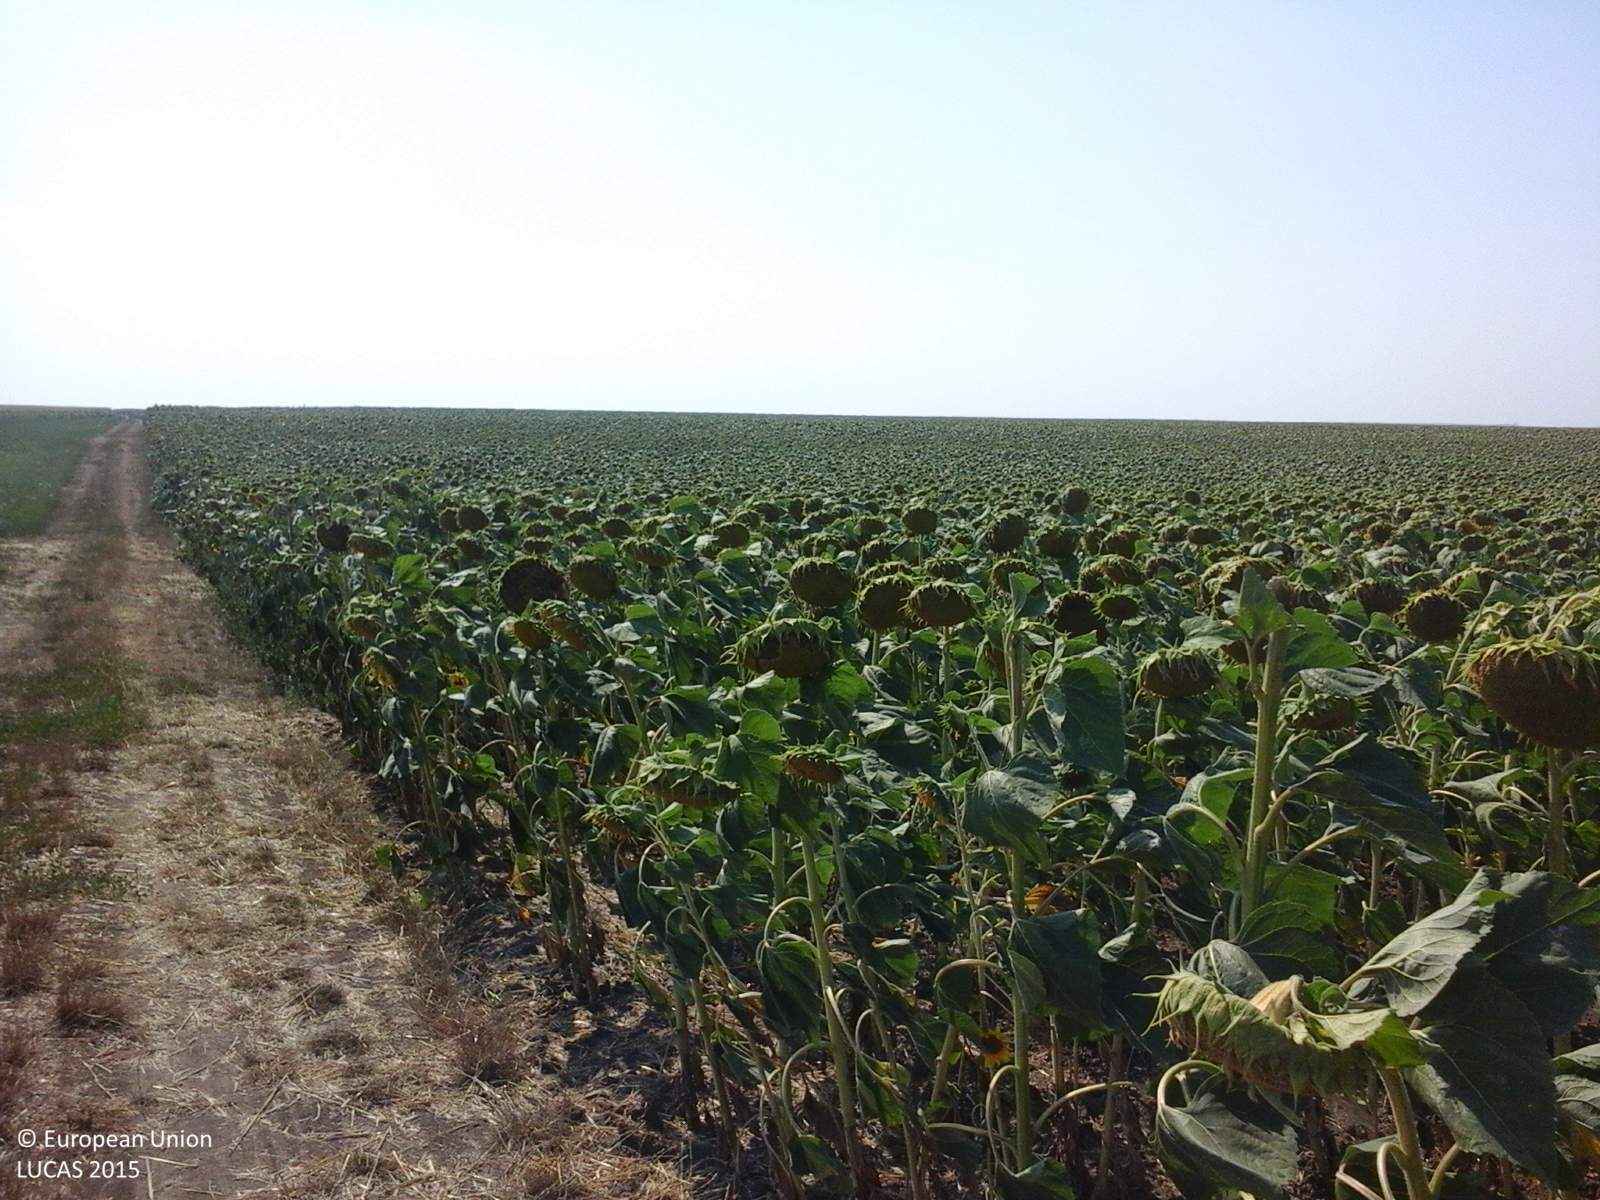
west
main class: Cropland
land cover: Sunflower
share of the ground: > 75 %
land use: Agriculture (excluding fallow land and kitchen gardens)
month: July
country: RO
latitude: 46.0163
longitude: 27.5051
